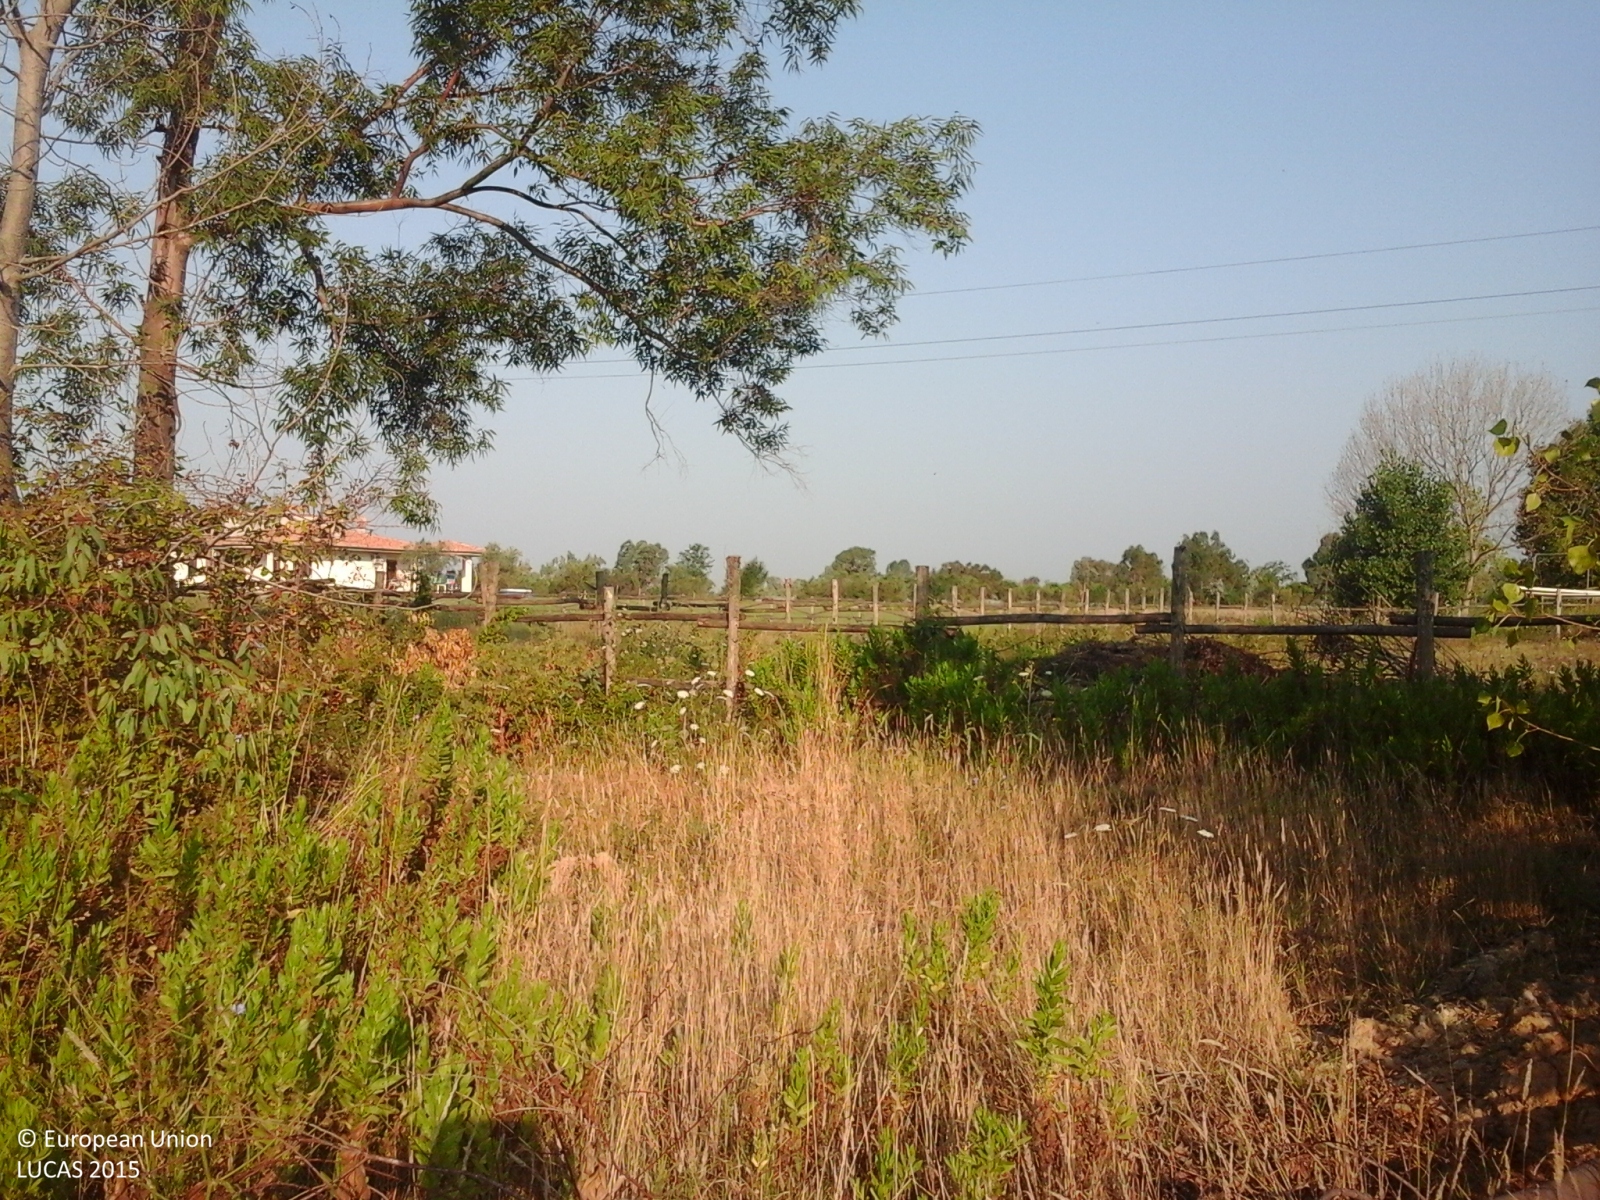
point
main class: Grassland
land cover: Grassland without tree/shrub cover
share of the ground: > 75 %
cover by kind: herbaceous plants 100 %
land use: Residential
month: July
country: IT
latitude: 41.4575
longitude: 12.8259
